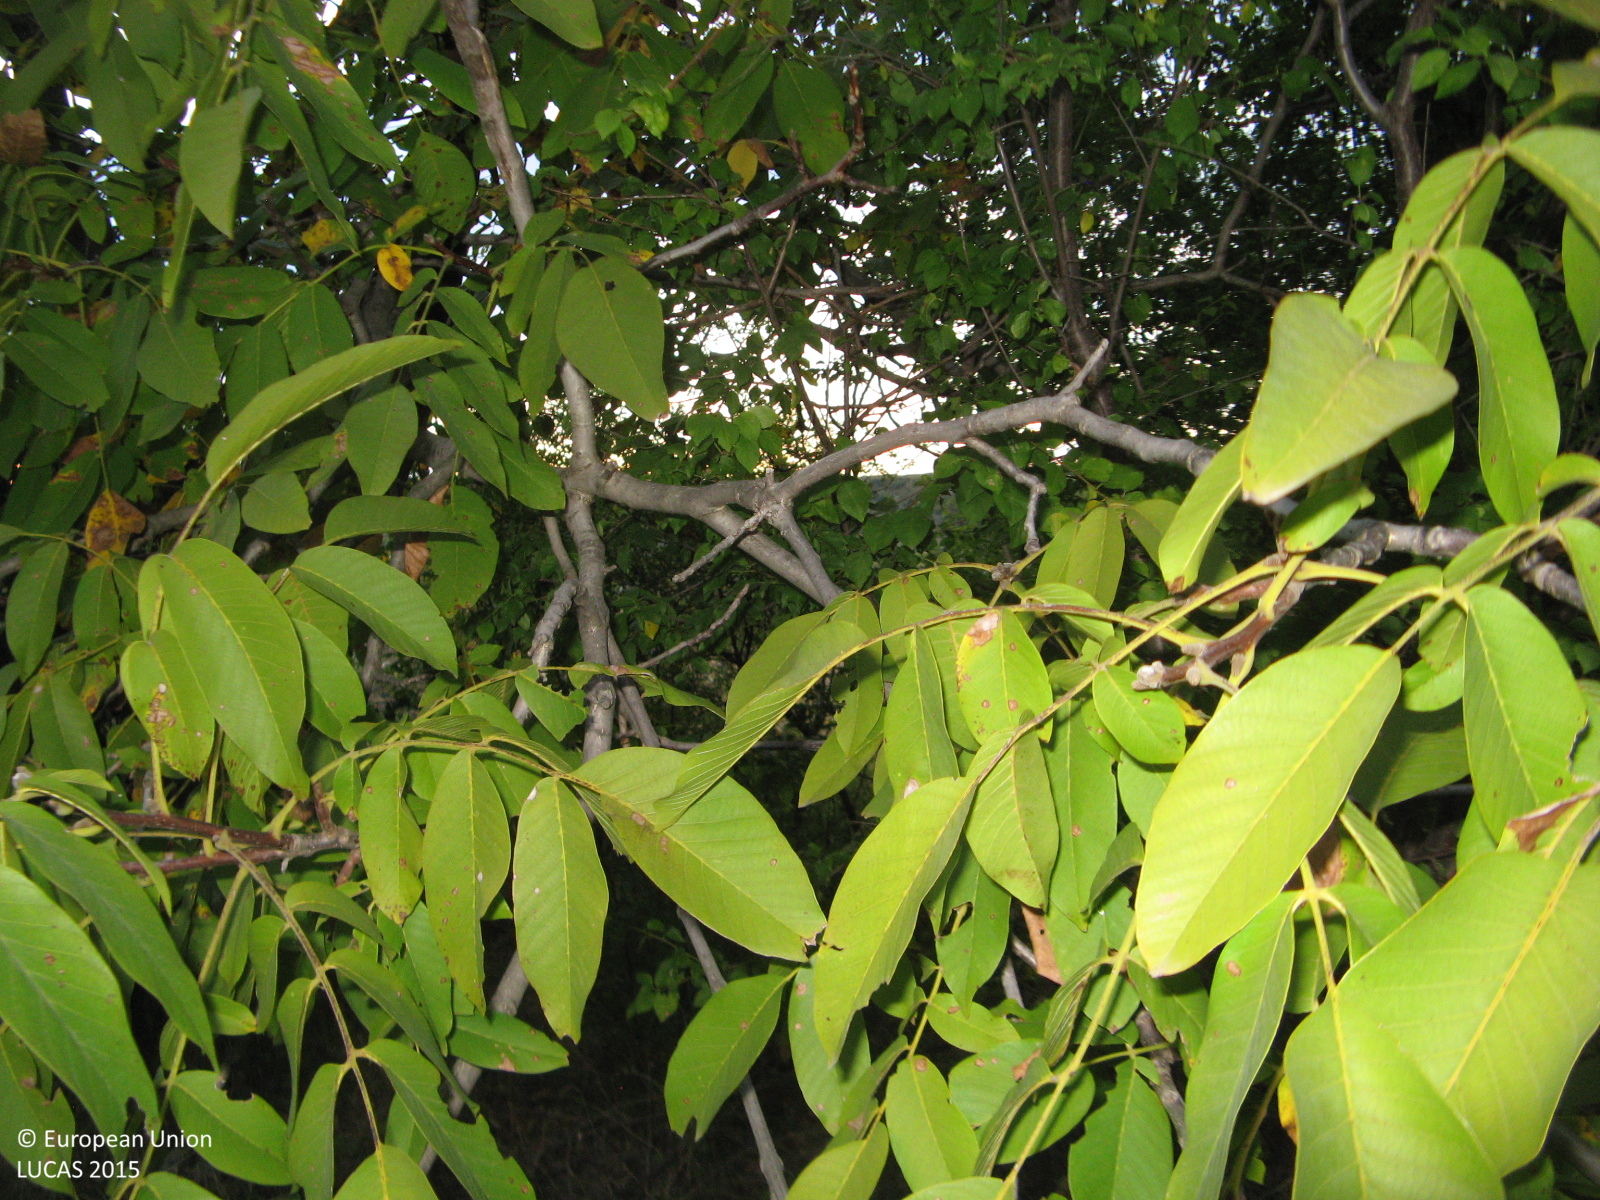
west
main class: Grassland
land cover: Grassland with sparse tree/shrub cover
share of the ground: > 75 %
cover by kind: herbaceous plants 85 %, shrubs 10 %, broadleaved forest trees 5 %
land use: Fallow land
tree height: > 5 m
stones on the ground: < 10 %
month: October
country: BG
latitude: 41.9537
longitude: 25.3455
